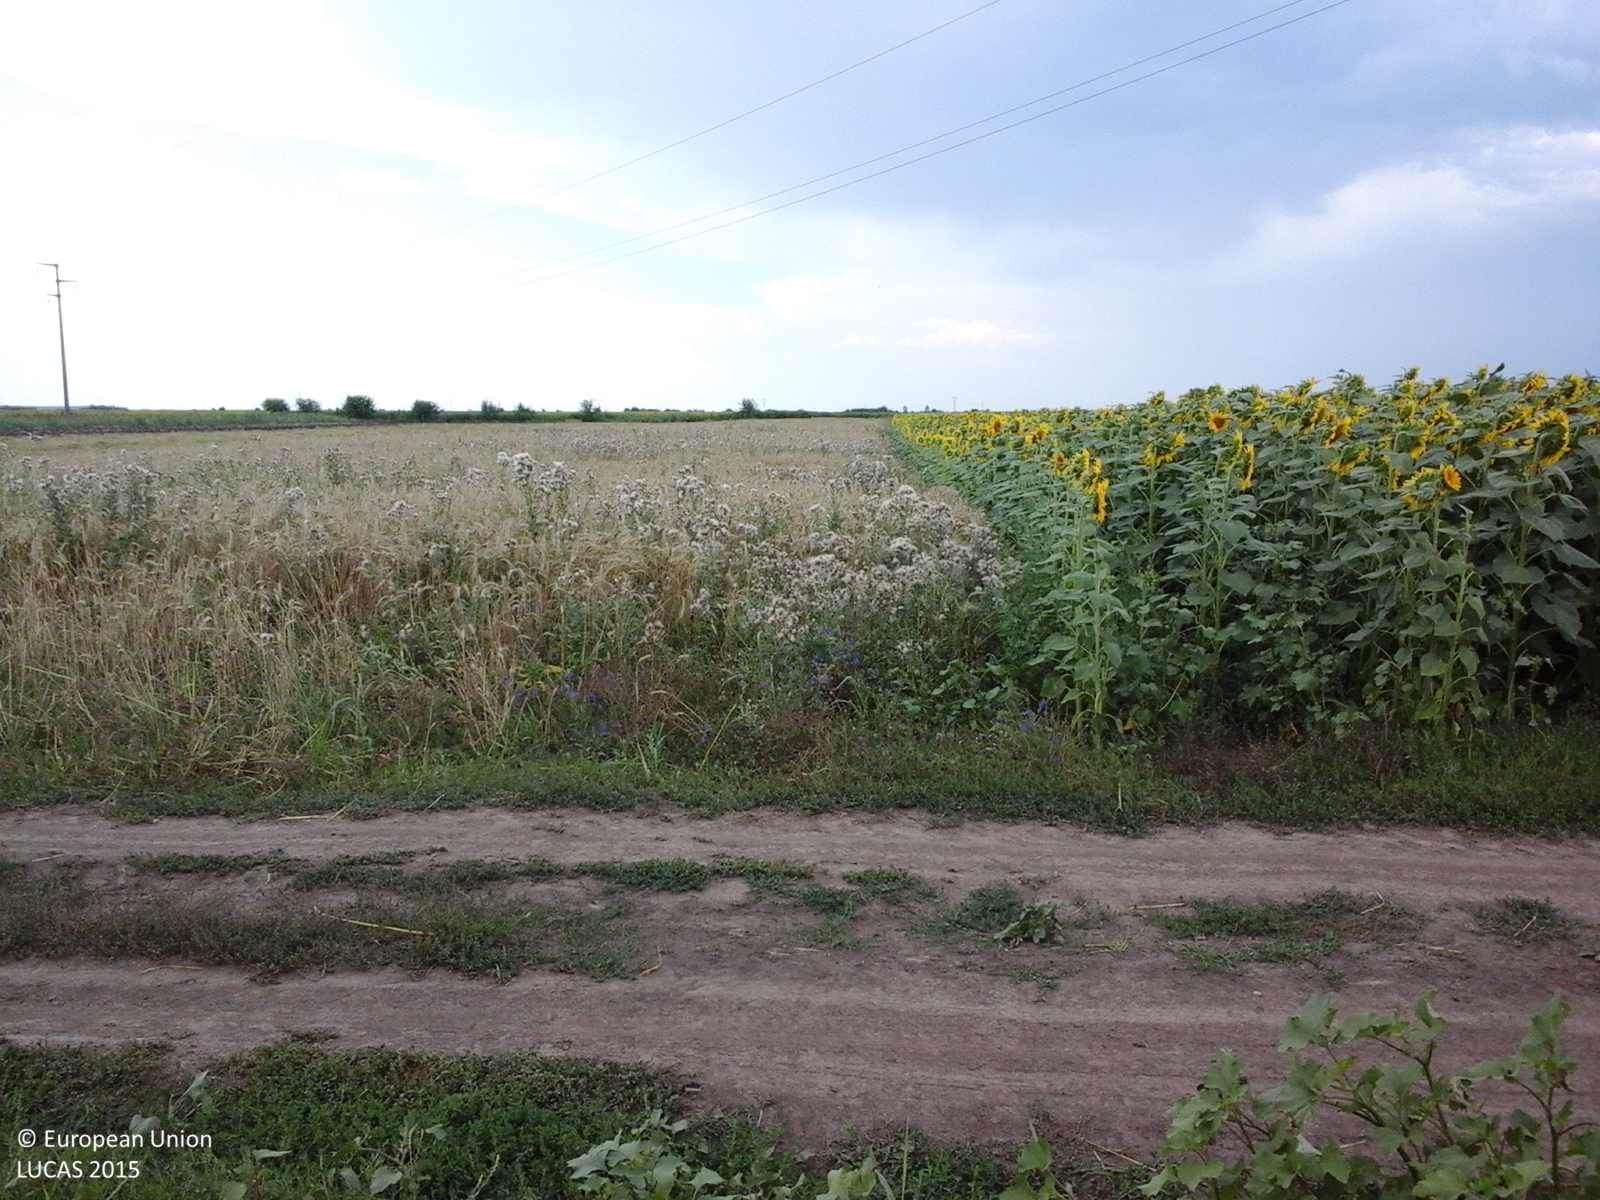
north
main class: Cropland
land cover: Sunflower
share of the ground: > 75 %
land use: Agriculture (excluding fallow land and kitchen gardens)
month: July
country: RO
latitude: 43.9010
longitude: 24.4445
